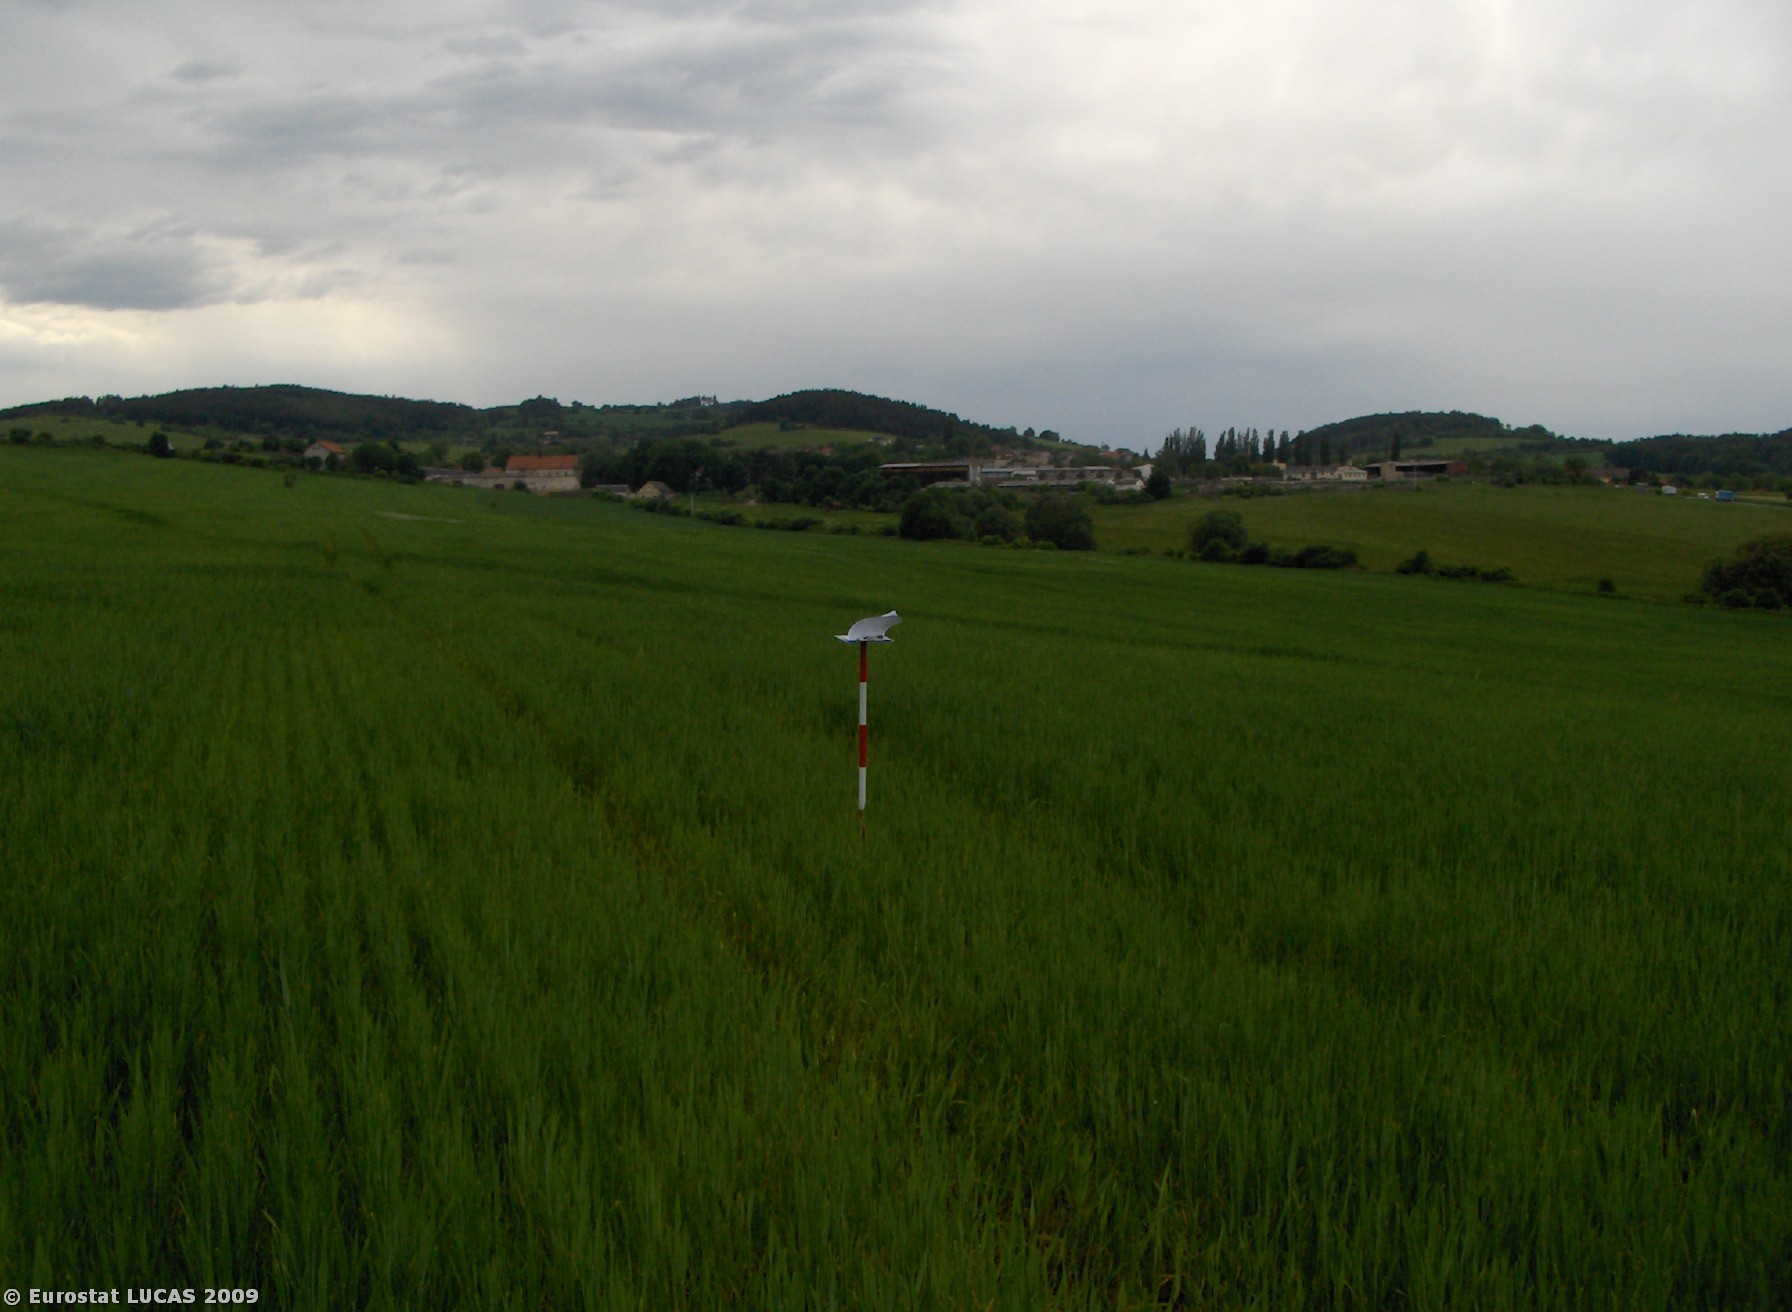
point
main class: Cropland
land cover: Common wheat
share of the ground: > 75 %
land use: Agriculture (excluding fallow land and kitchen gardens)
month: May
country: CZ
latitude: 49.6378
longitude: 14.2244
